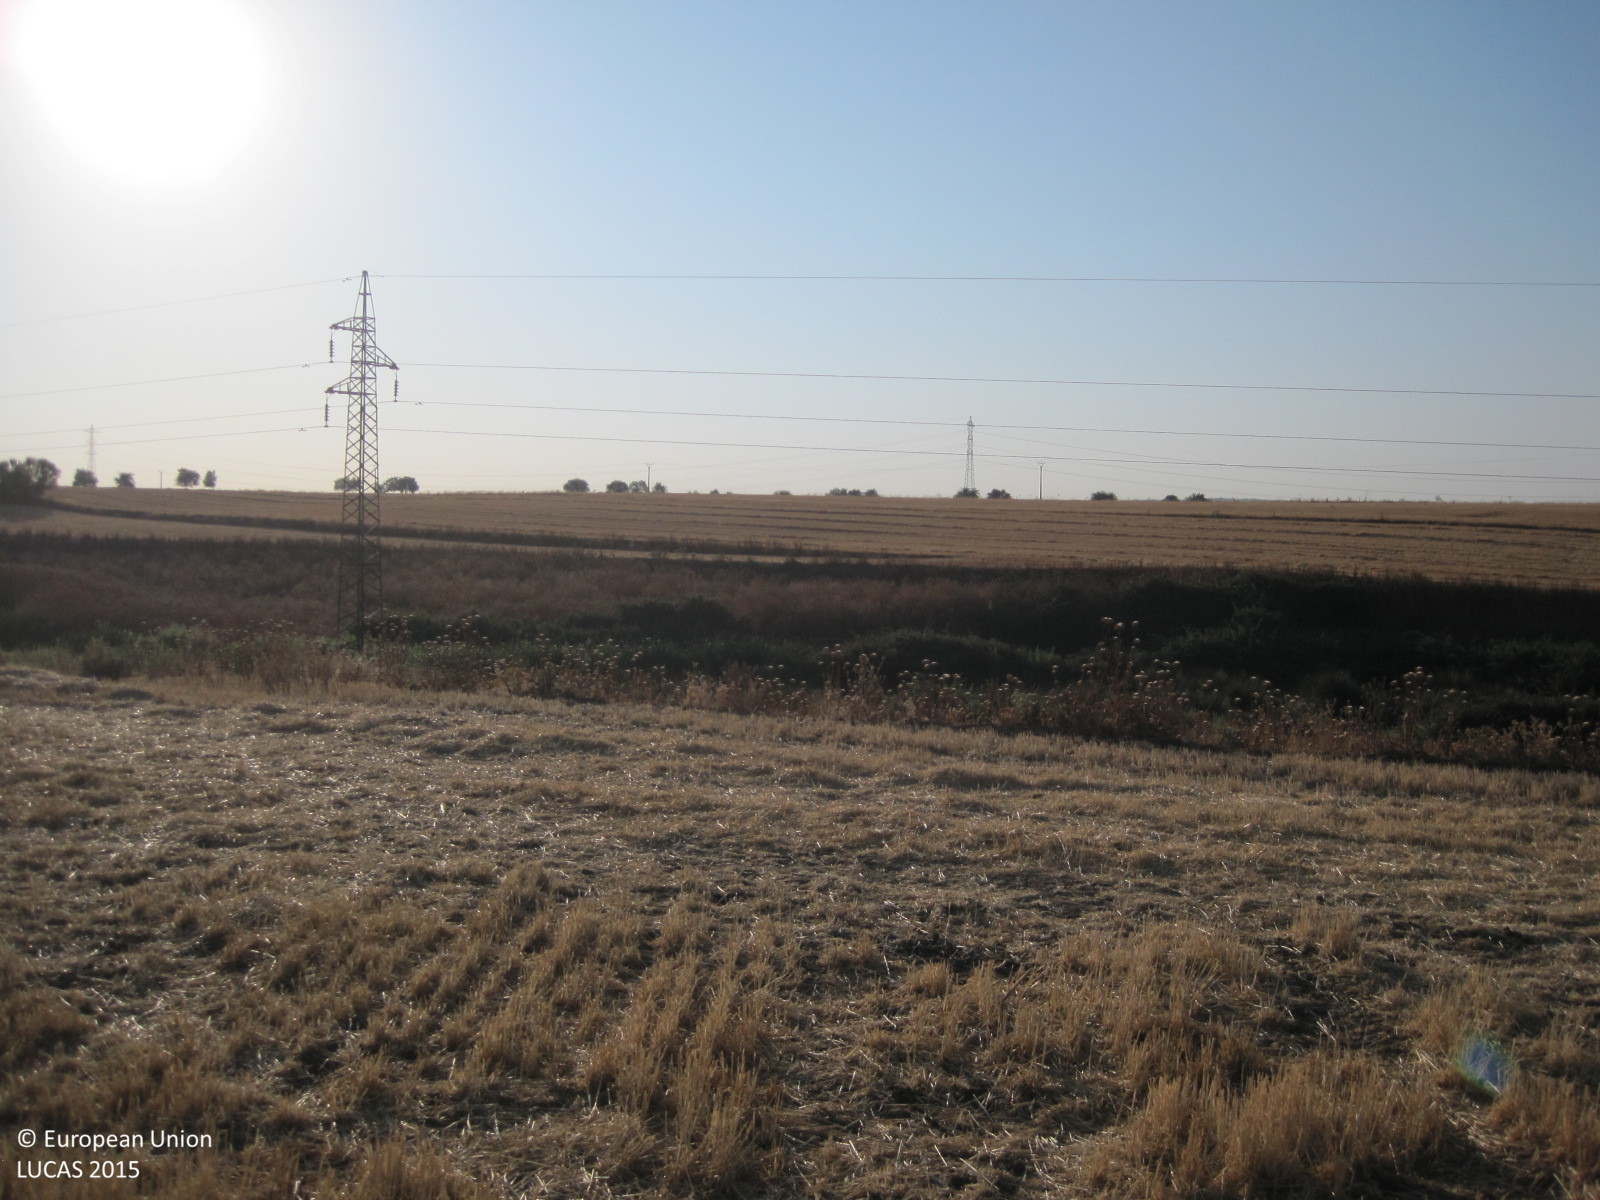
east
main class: Cropland
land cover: Barley
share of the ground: < 10 %
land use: Agriculture (excluding fallow land and kitchen gardens)
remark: Harvested field
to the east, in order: Barley; Grass margins; Spontaneously vegetated surfaces; Shrubland without tree cover; Electric lines; Shrubland without tree cover; Rivers and streams; Shruby margins; Barley; Grass margins; Arable land (only in case pi); Grass margins; Arable land (only in case pi); Grass margins; Arable land (only in case pi); Grass margins; Arable land (only in case pi)
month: July
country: ES
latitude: 40.1653
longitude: -3.8085
